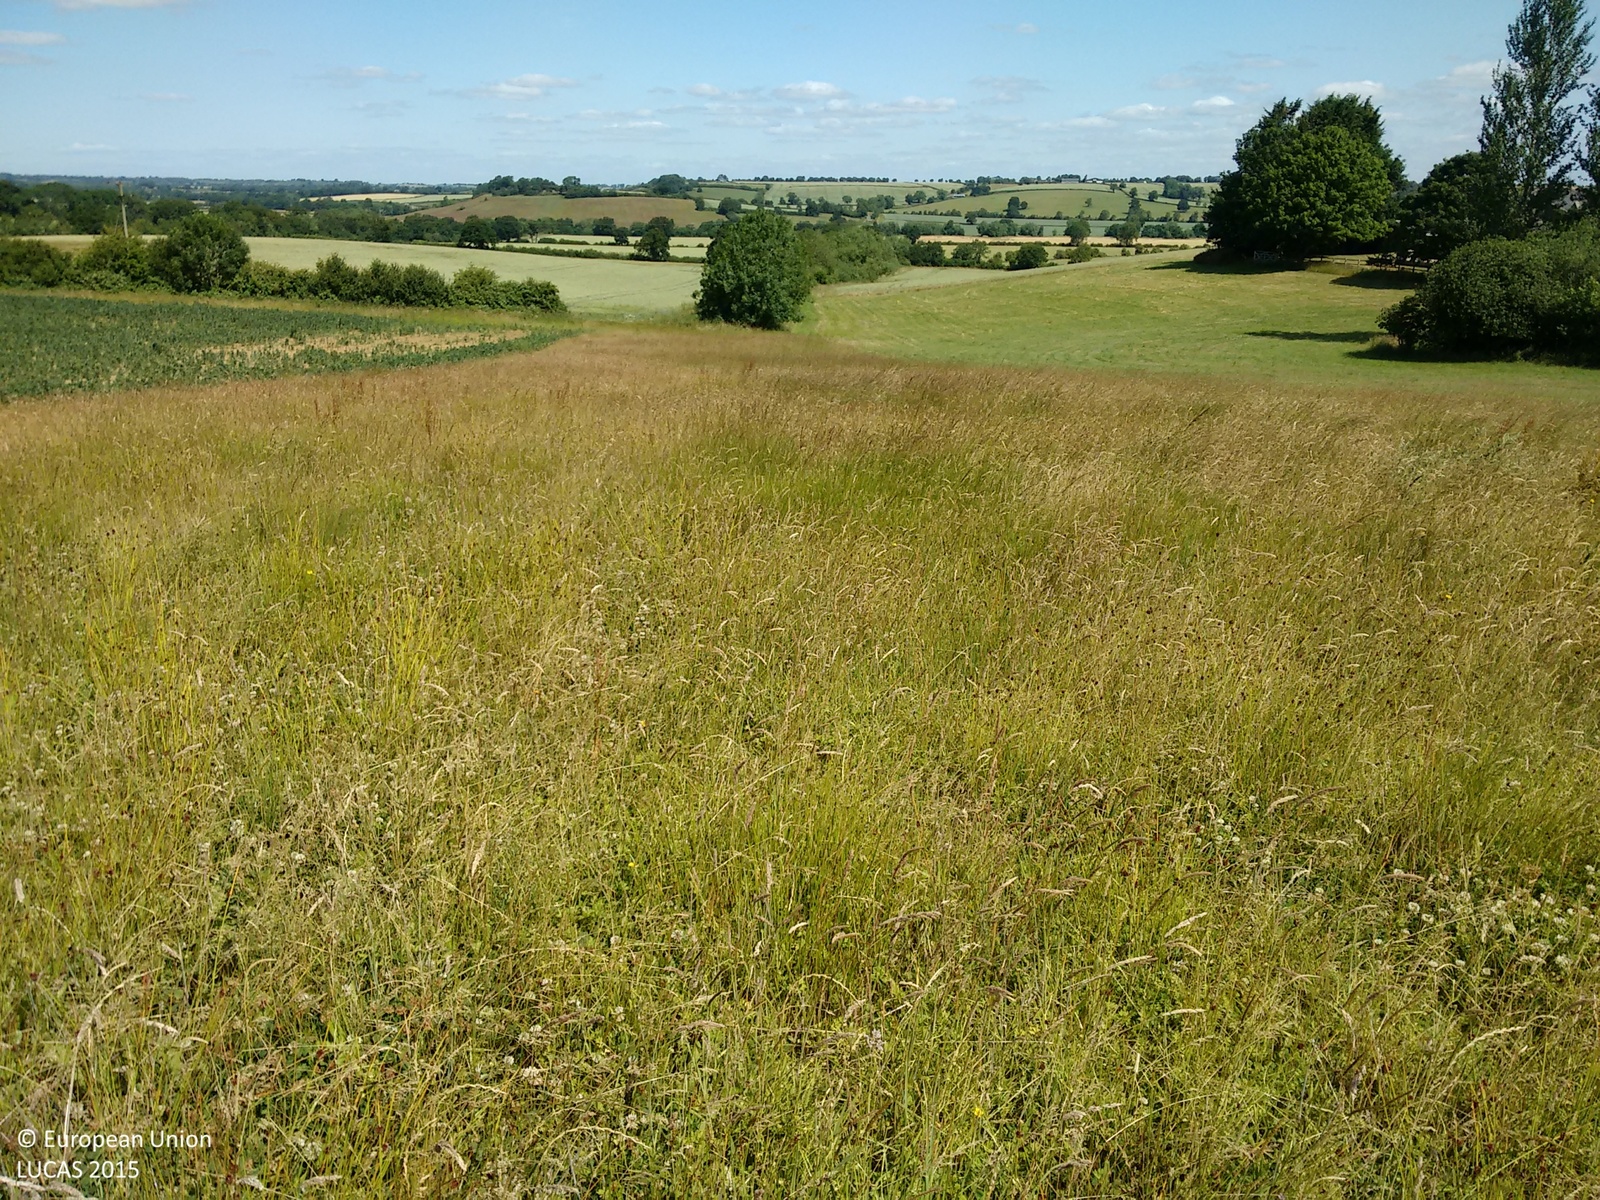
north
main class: Grassland
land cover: Grassland without tree/shrub cover
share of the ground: > 75 %
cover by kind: herbaceous plants 100 %
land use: Agriculture (excluding fallow land and kitchen gardens)
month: July
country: GB
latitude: 51.9576
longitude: -1.3561
